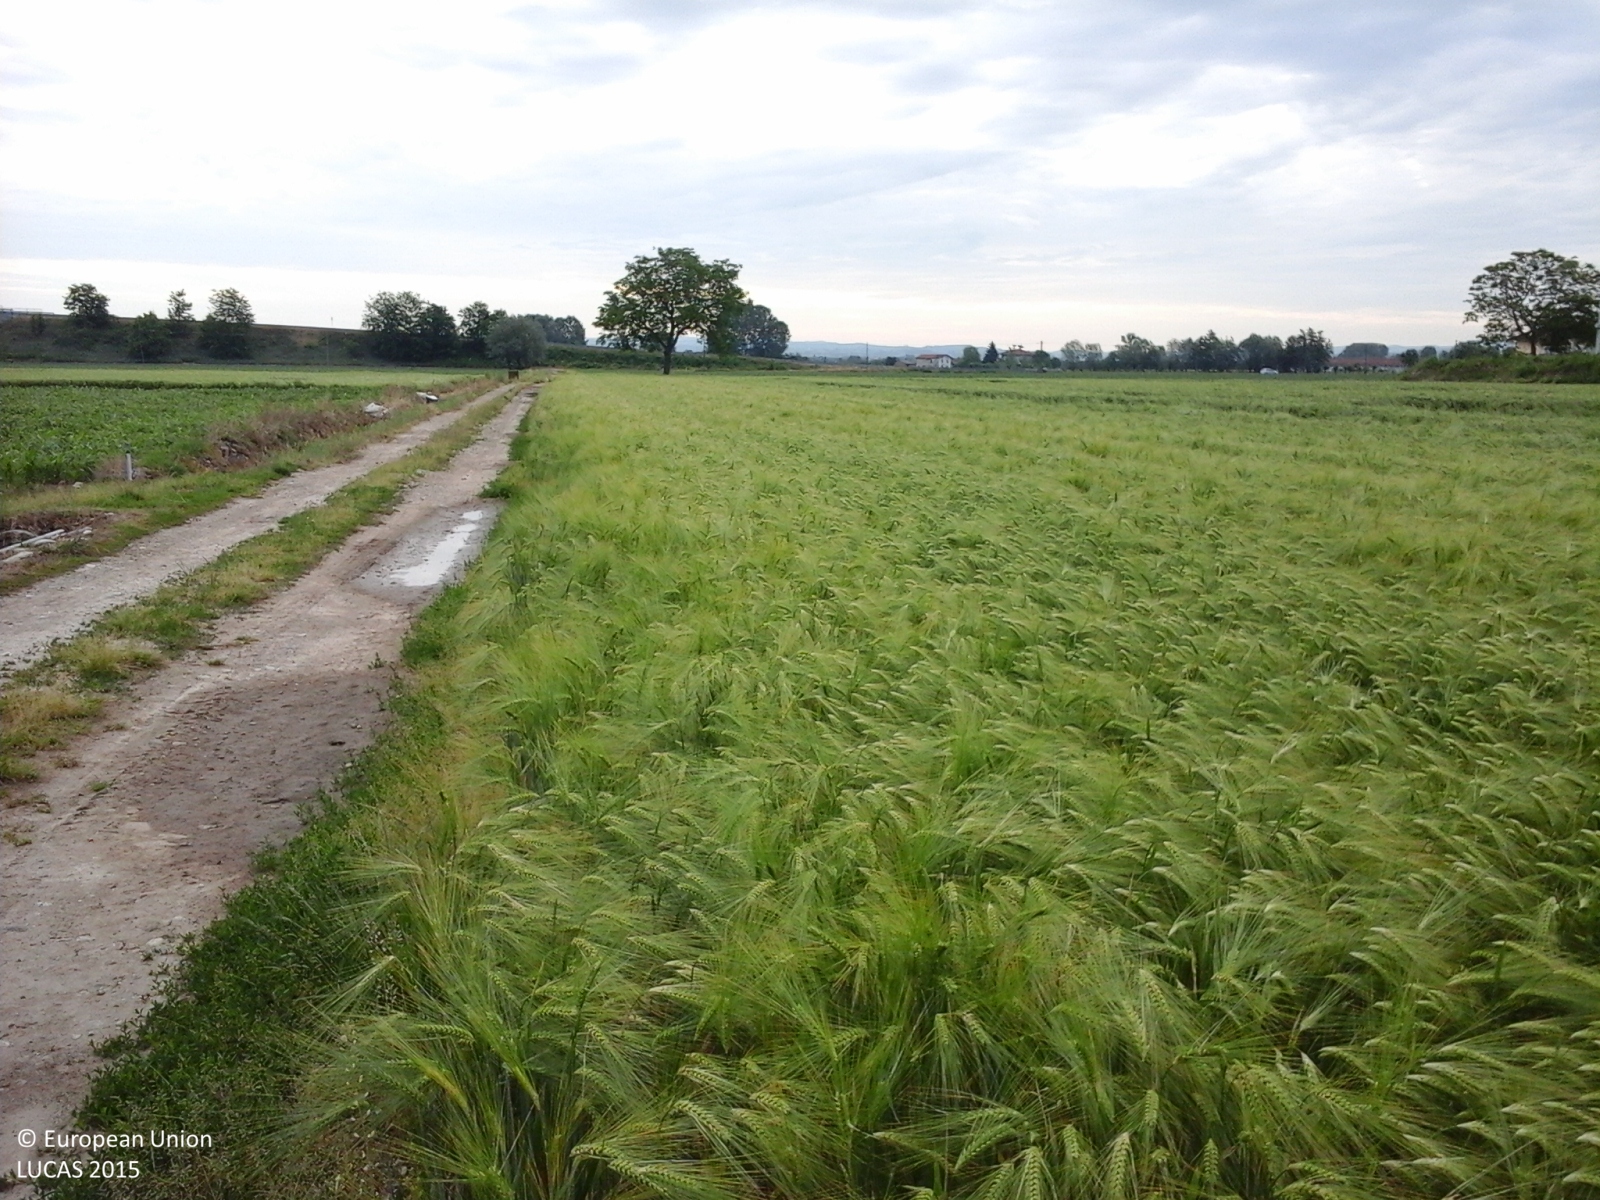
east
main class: Cropland
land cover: Barley
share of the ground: > 75 %
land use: Agriculture (excluding fallow land and kitchen gardens)
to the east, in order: Barley; Ditches and canals; Maize
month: May
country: IT
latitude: 44.4695
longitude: 7.7044
